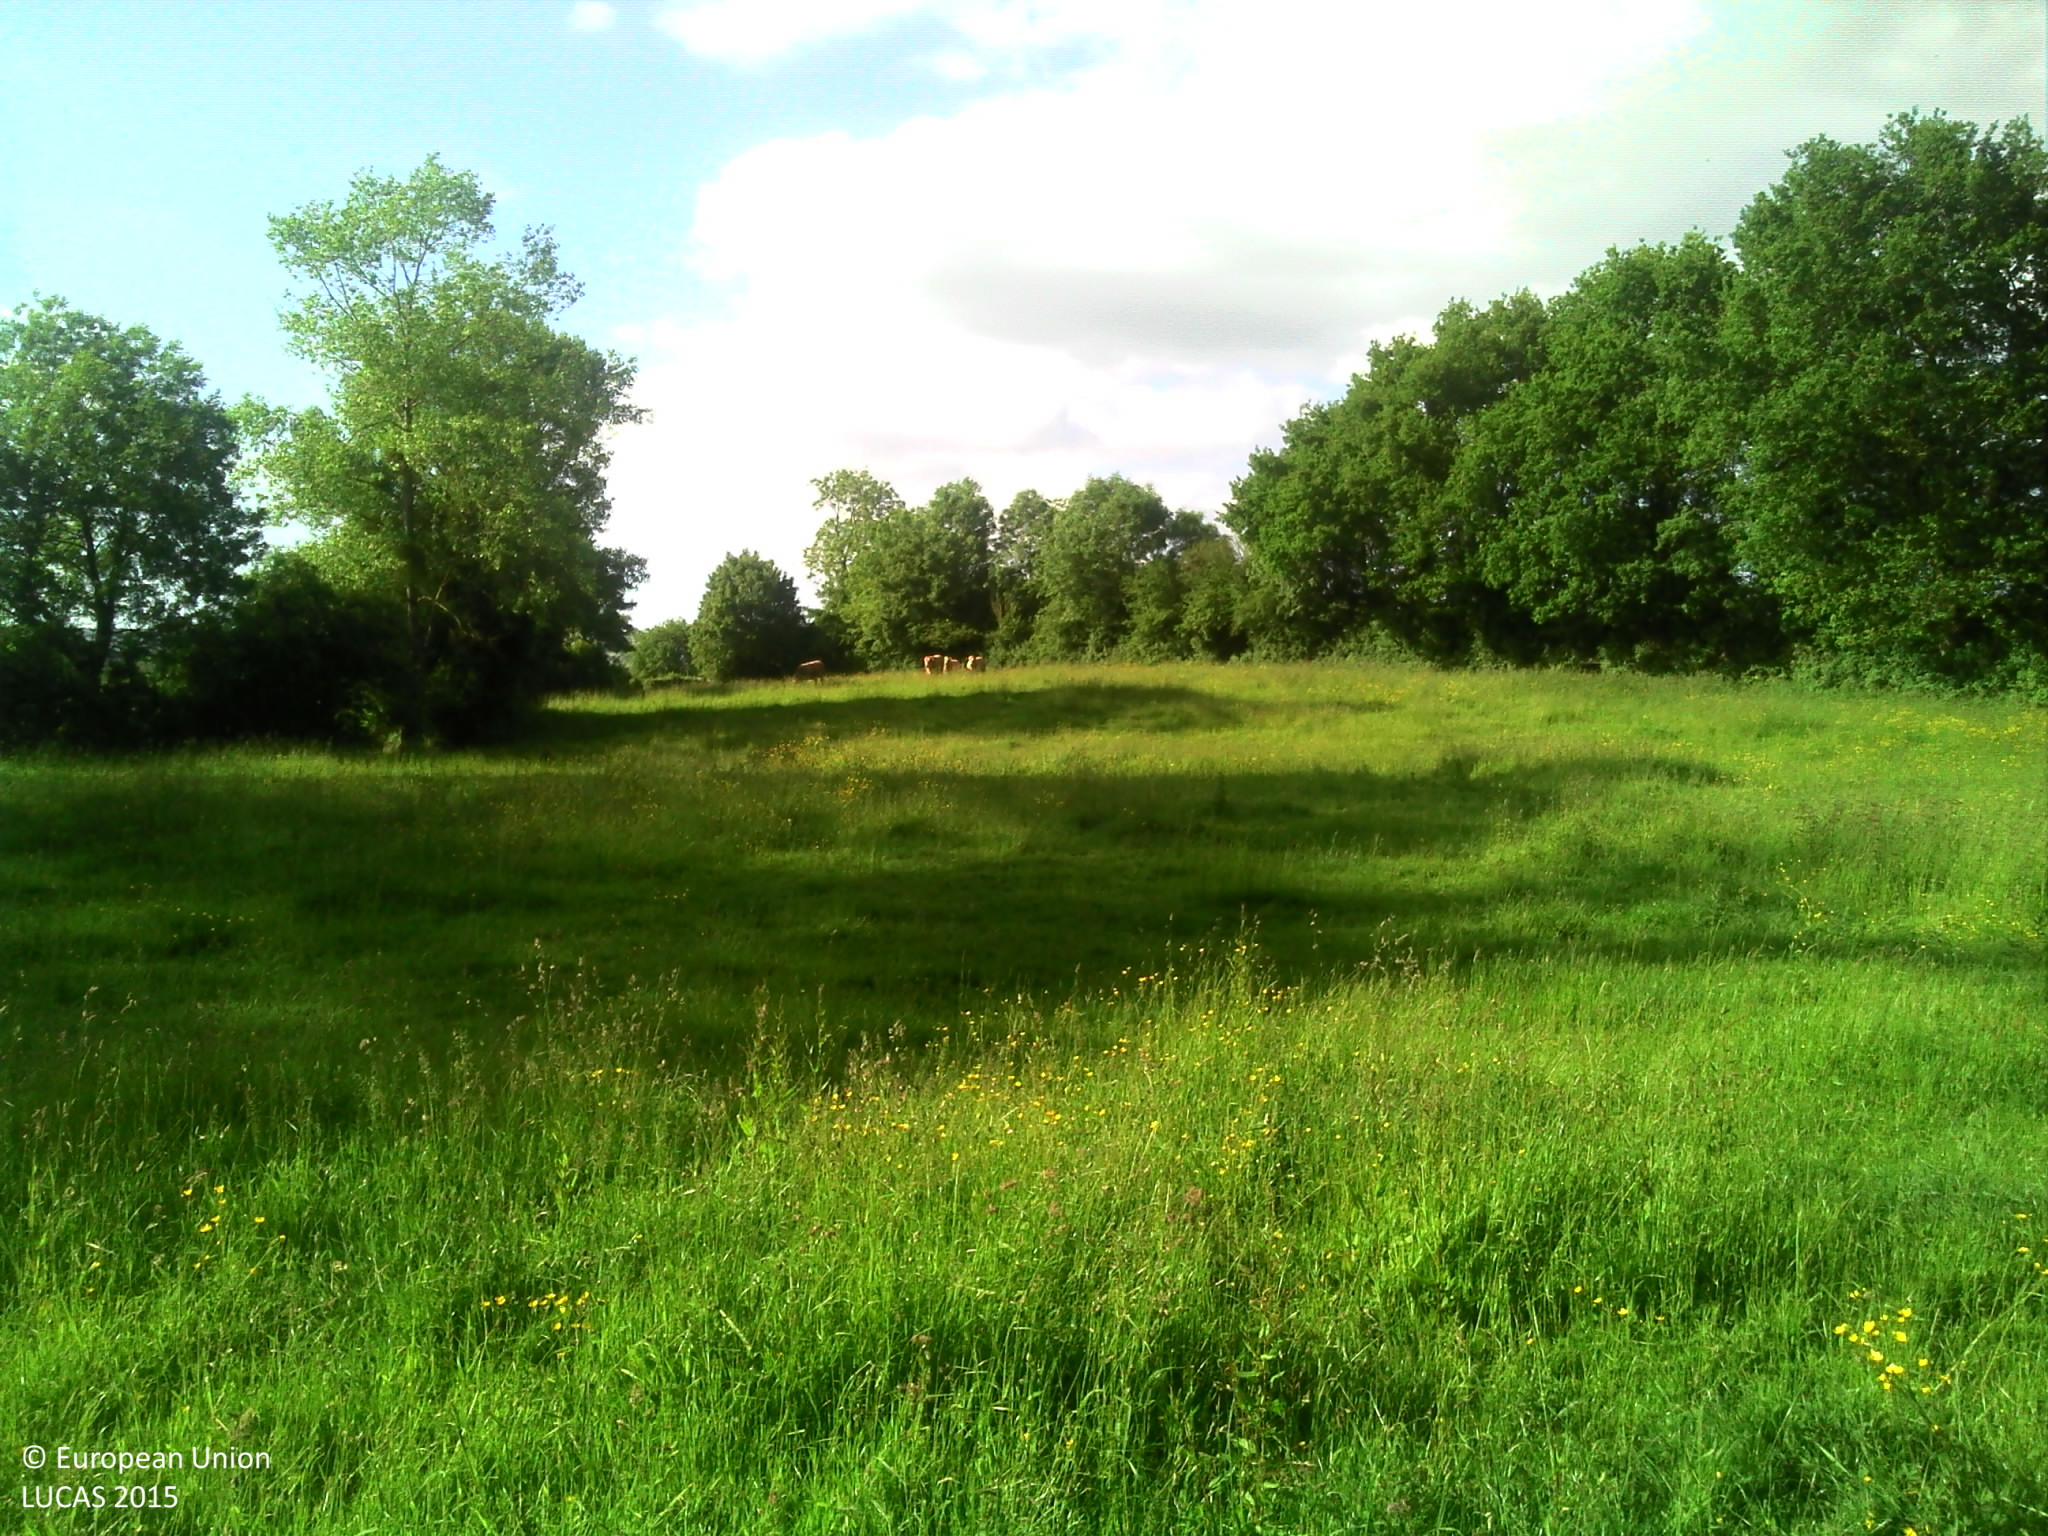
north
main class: Grassland
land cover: Grassland without tree/shrub cover
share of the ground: > 75 %
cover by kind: herbaceous plants 100 %
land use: Agriculture (excluding fallow land and kitchen gardens)
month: June
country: FR
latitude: 48.8301
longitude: 0.1218
